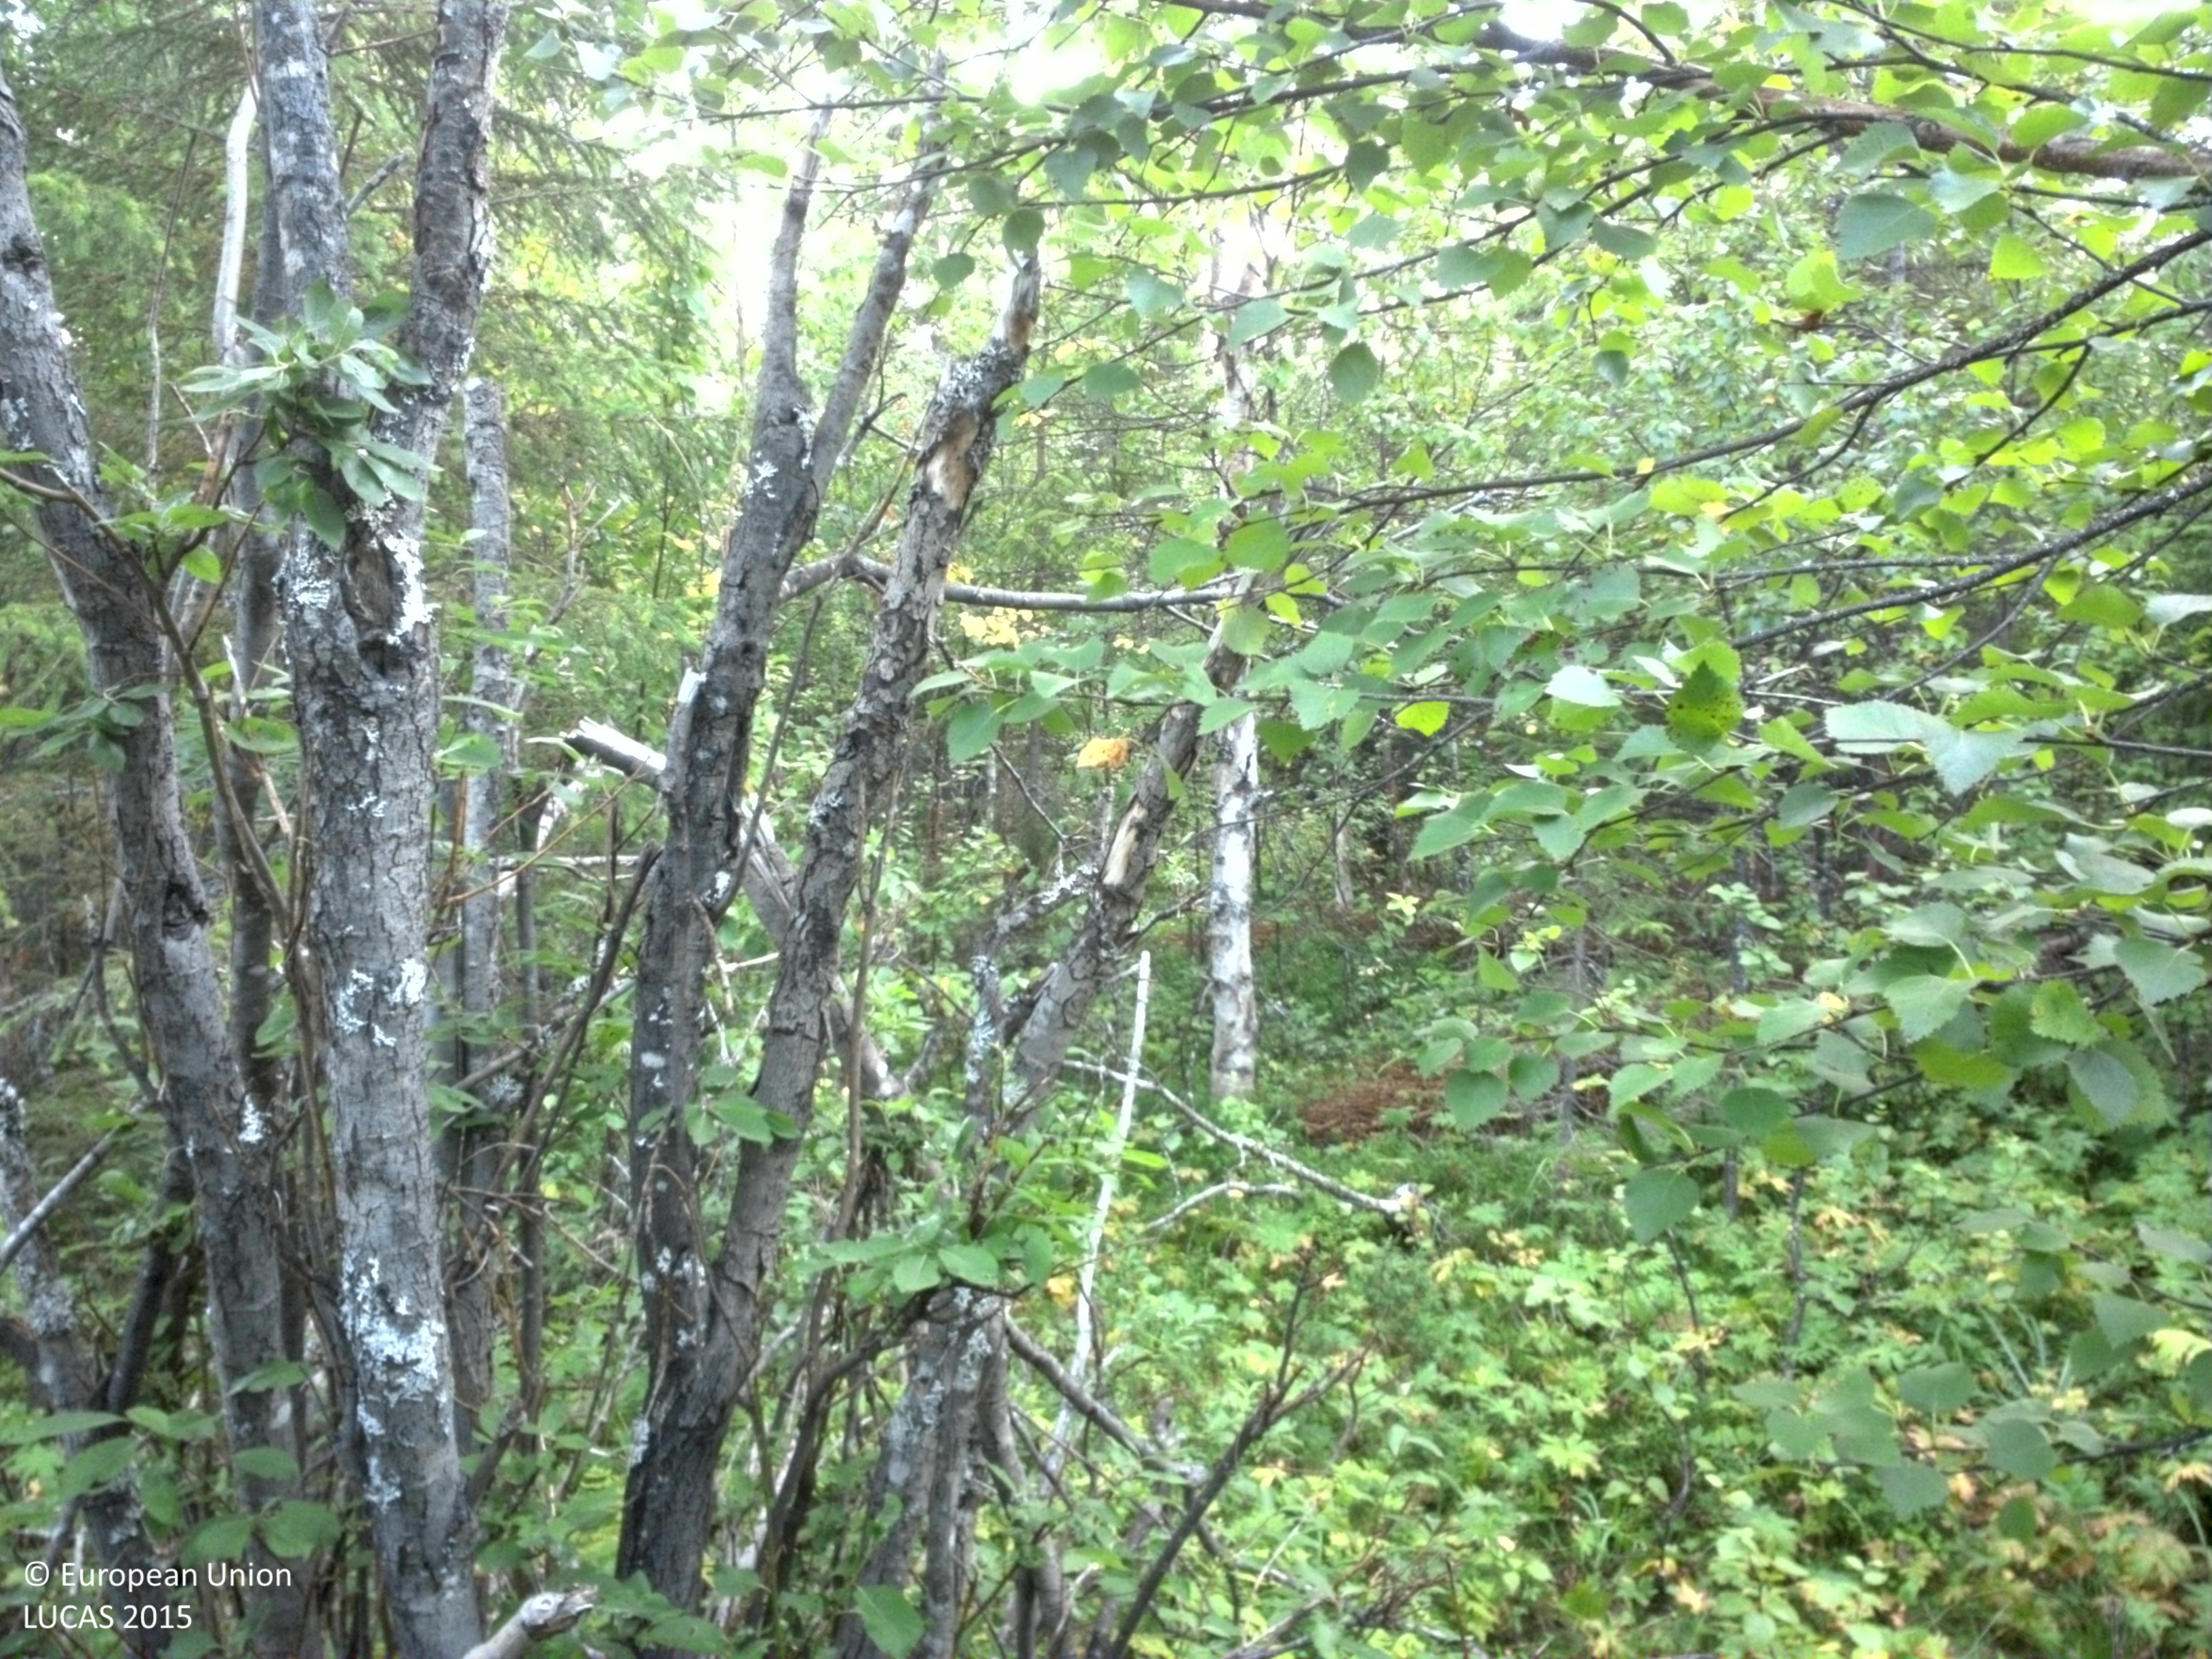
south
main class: Woodland
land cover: Spruce dominated mixed woodland
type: boreal forest
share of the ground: 50 - 75 %
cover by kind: broadleaved forest trees 40 %, coniferous forest trees 30 %, shrubs 15 %, herbaceous plants 15 %
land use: Forestry
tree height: > 5 m
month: September
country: SE
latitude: 65.1825
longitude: 16.2204
